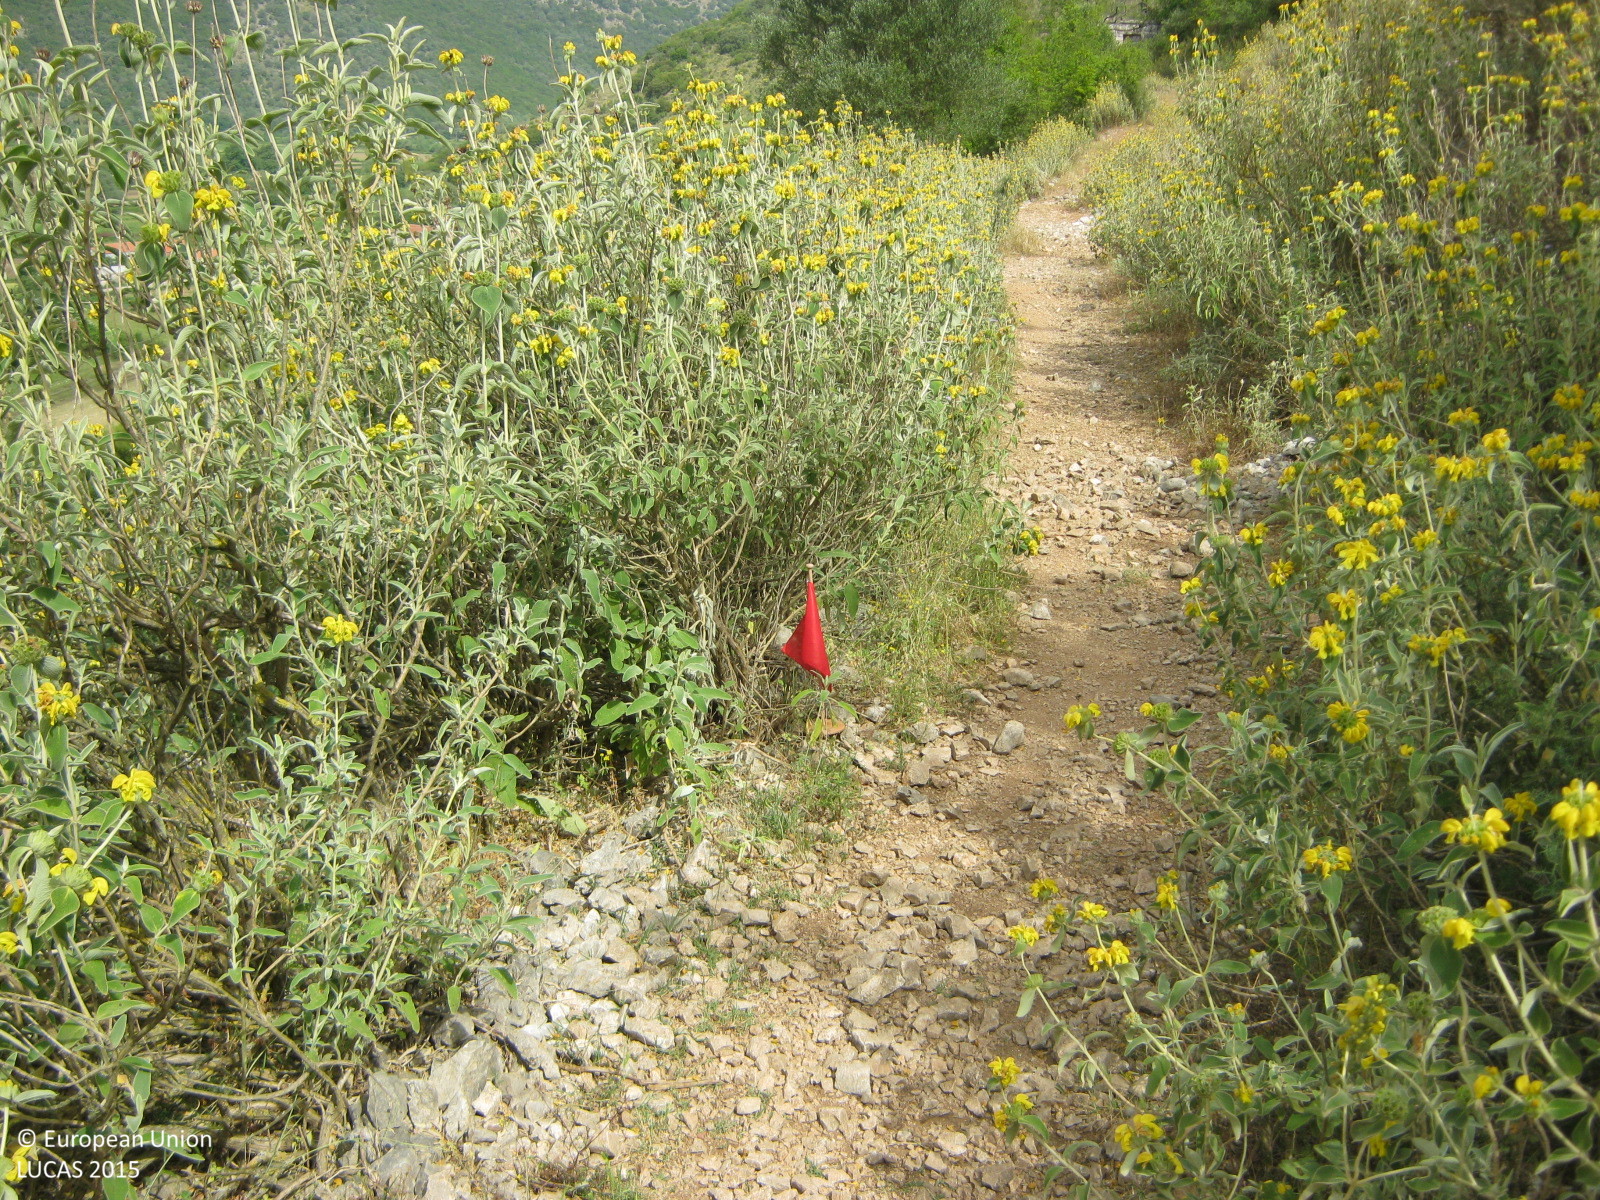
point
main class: Shrubland
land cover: Shrubland without tree cover
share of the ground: 50 - 75 %
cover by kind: shrubs 50 %, herbaceous plants 40 %, consolidated bare surface 10 %
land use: Agriculture (excluding fallow land and kitchen gardens)
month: May
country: GR
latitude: 39.3127
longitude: 20.8885
